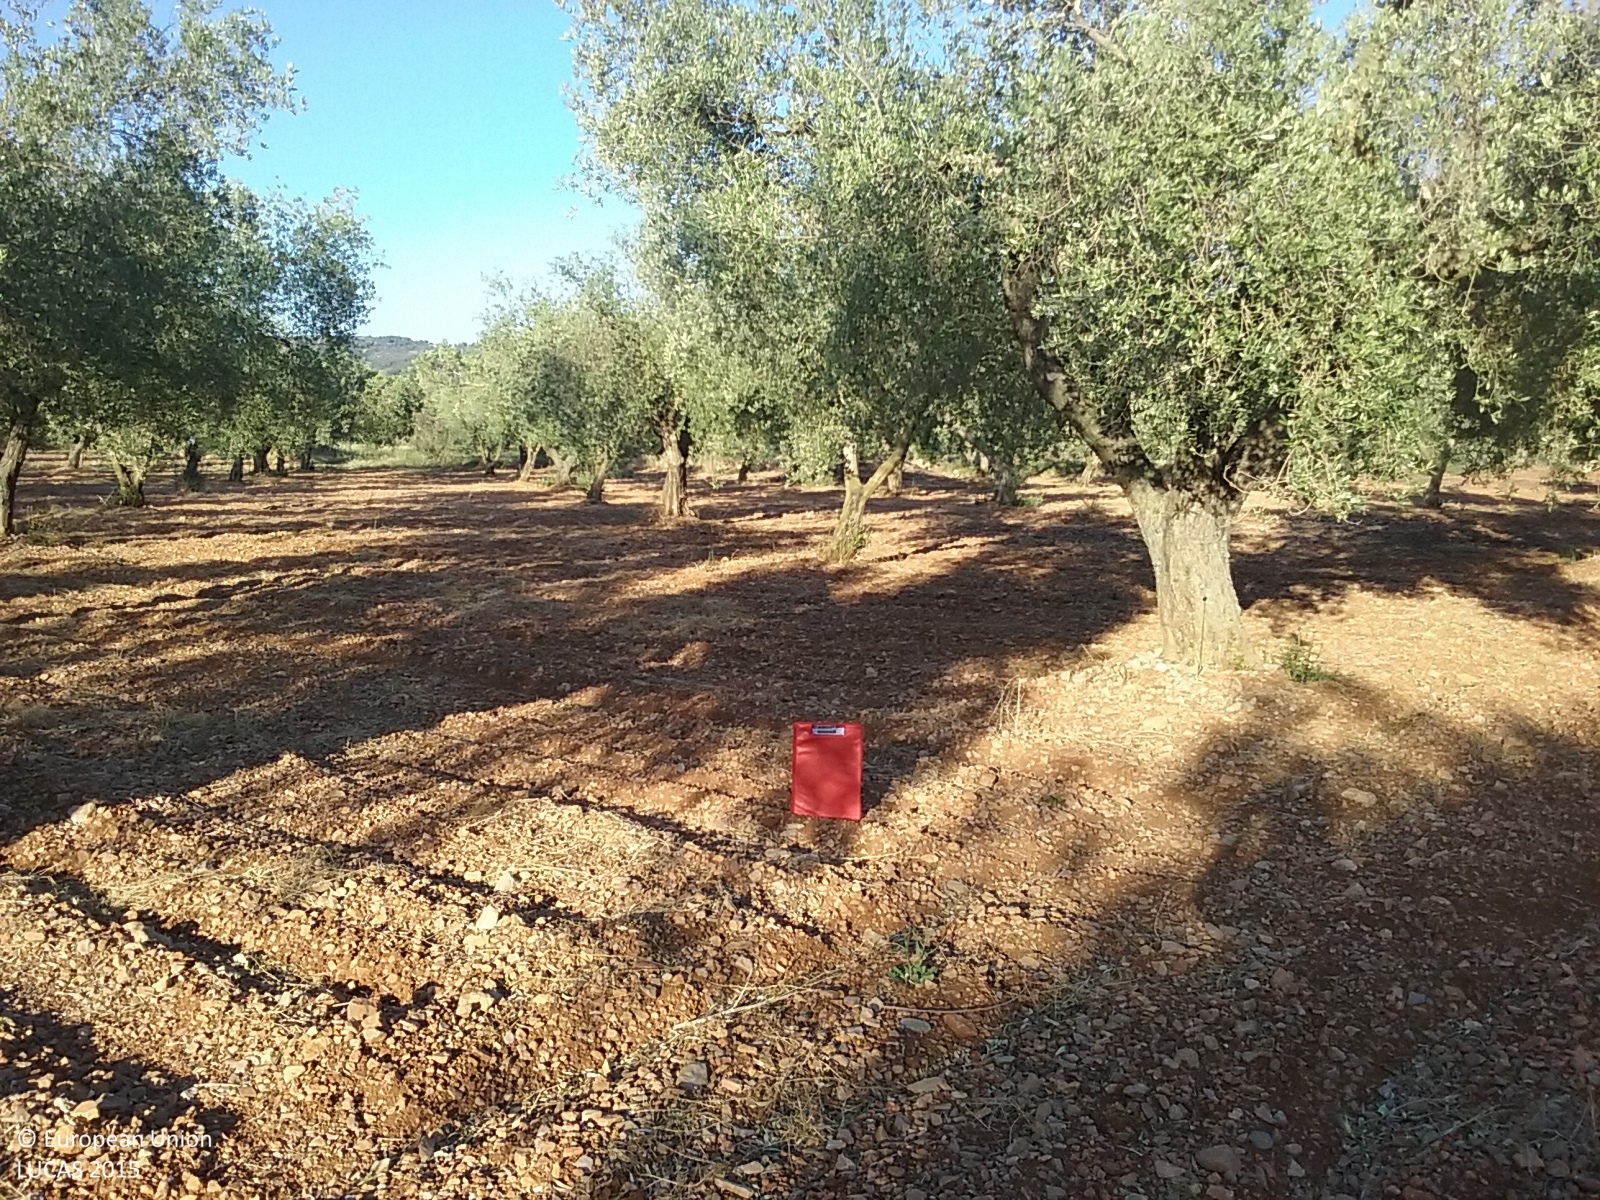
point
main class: Cropland
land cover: Olive groves
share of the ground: 50 - 75 %
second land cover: Other bare soil
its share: > 75 %
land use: Agriculture (excluding fallow land and kitchen gardens)
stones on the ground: 25 - 50 %
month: May
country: ES
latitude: 40.4171
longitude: 0.0604
